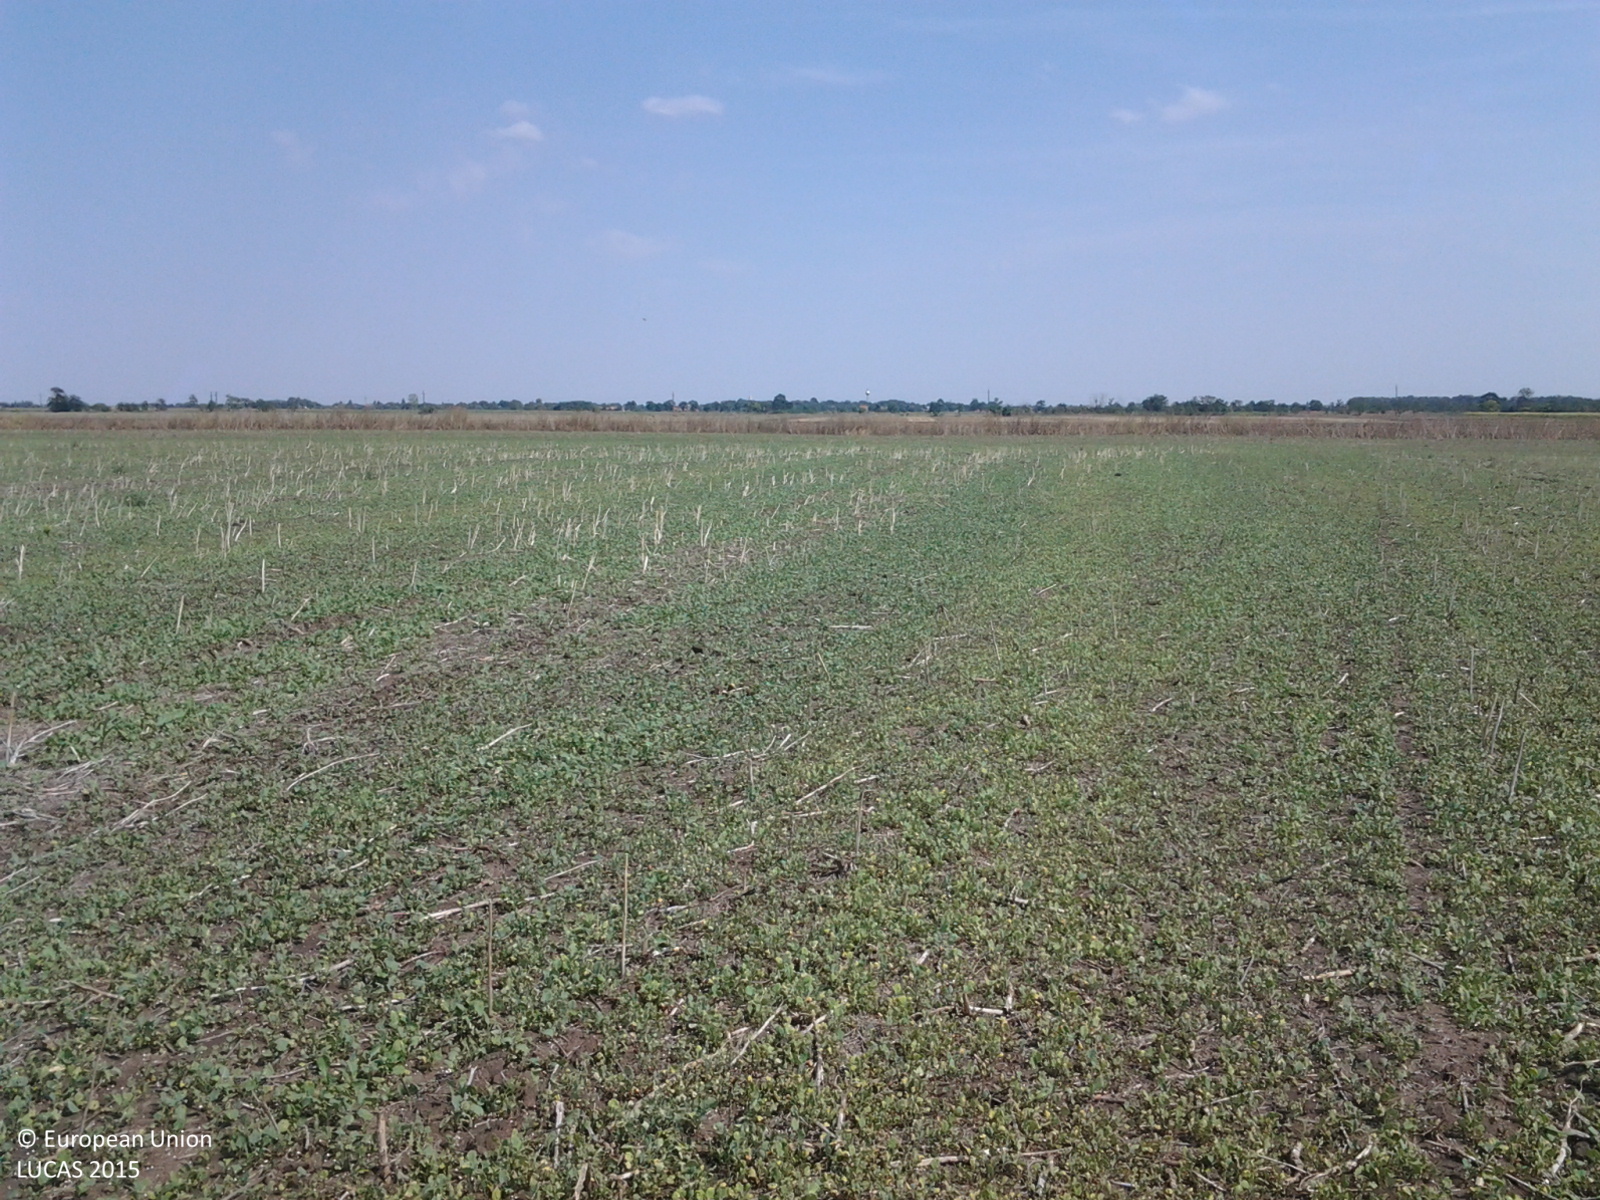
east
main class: Cropland
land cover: Other fibre and oleaginous crops
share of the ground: > 75 %
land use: Agriculture (excluding fallow land and kitchen gardens)
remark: Harvested field
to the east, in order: Other fibre and oleaginous crops; Ditches and canals; Shruby margins; Other bare soil
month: August
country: HU
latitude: 47.3407
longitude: 19.9113
